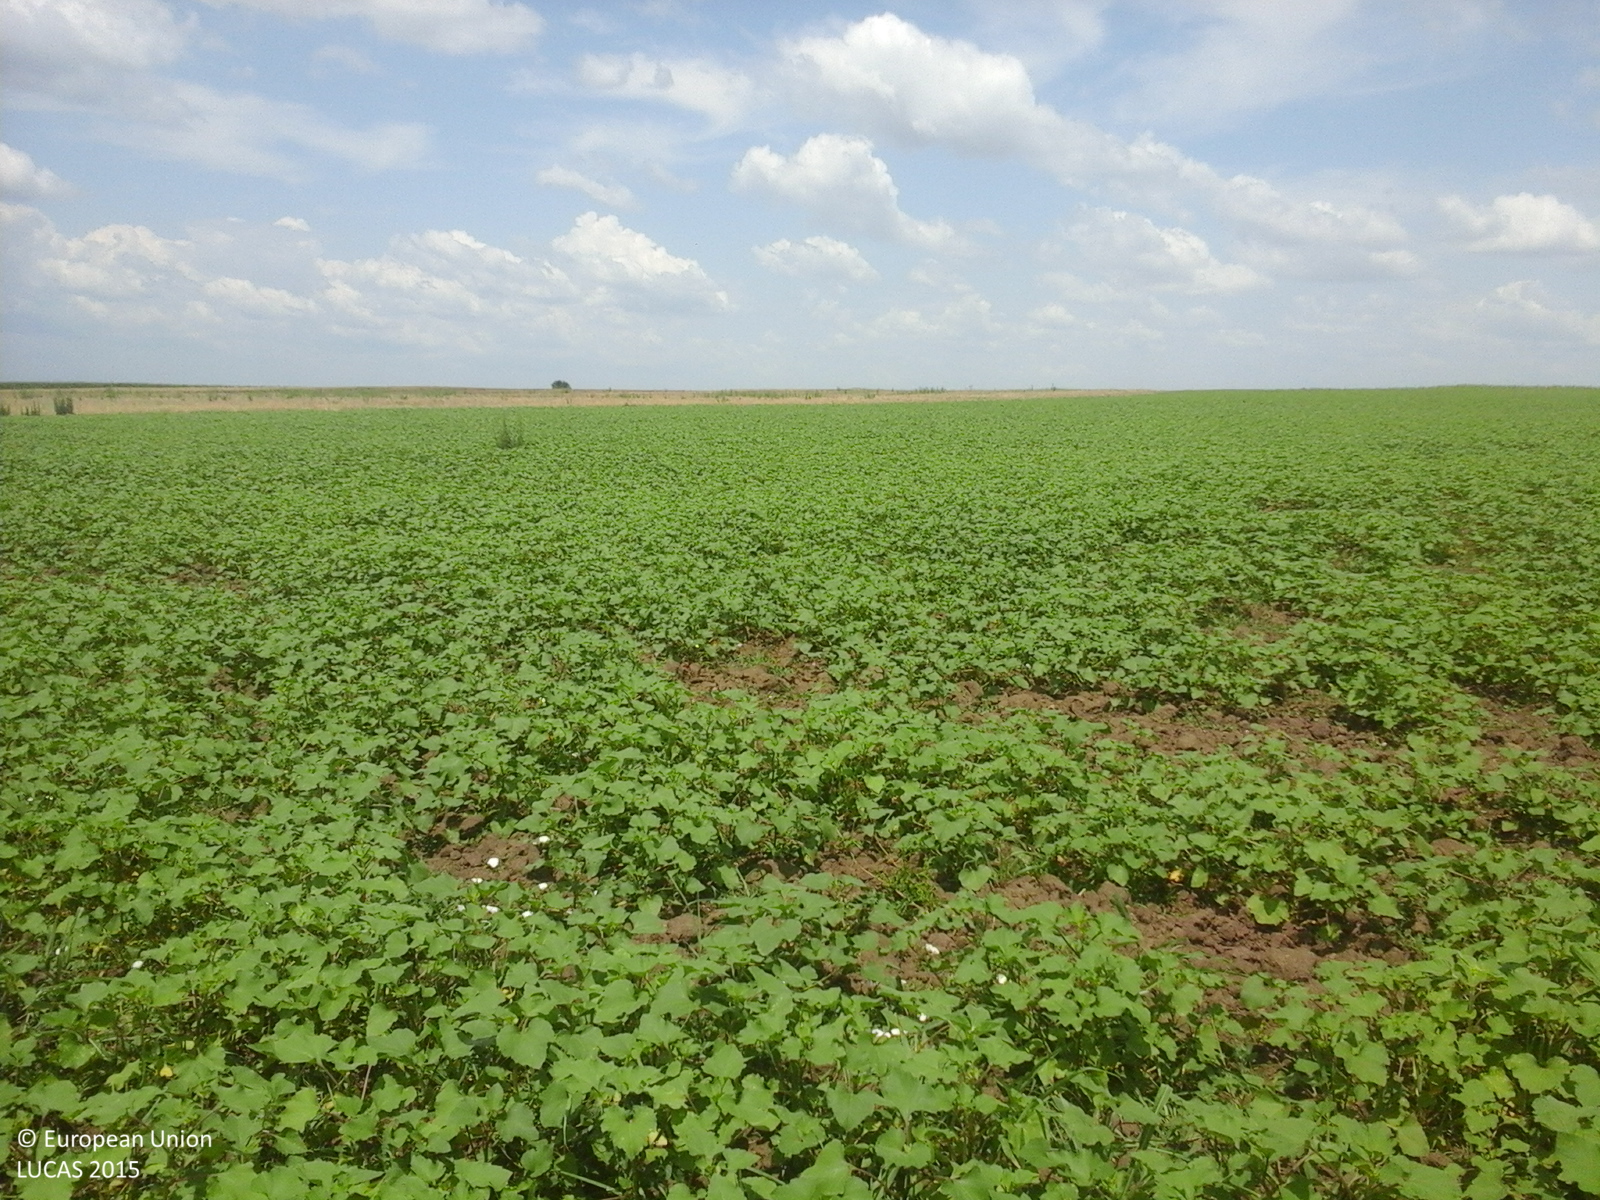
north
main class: Grassland
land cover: Spontaneously vegetated surfaces
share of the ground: > 75 %
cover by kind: herbaceous plants 100 %
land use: Fallow land
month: July
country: RO
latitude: 43.8789
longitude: 24.2107
